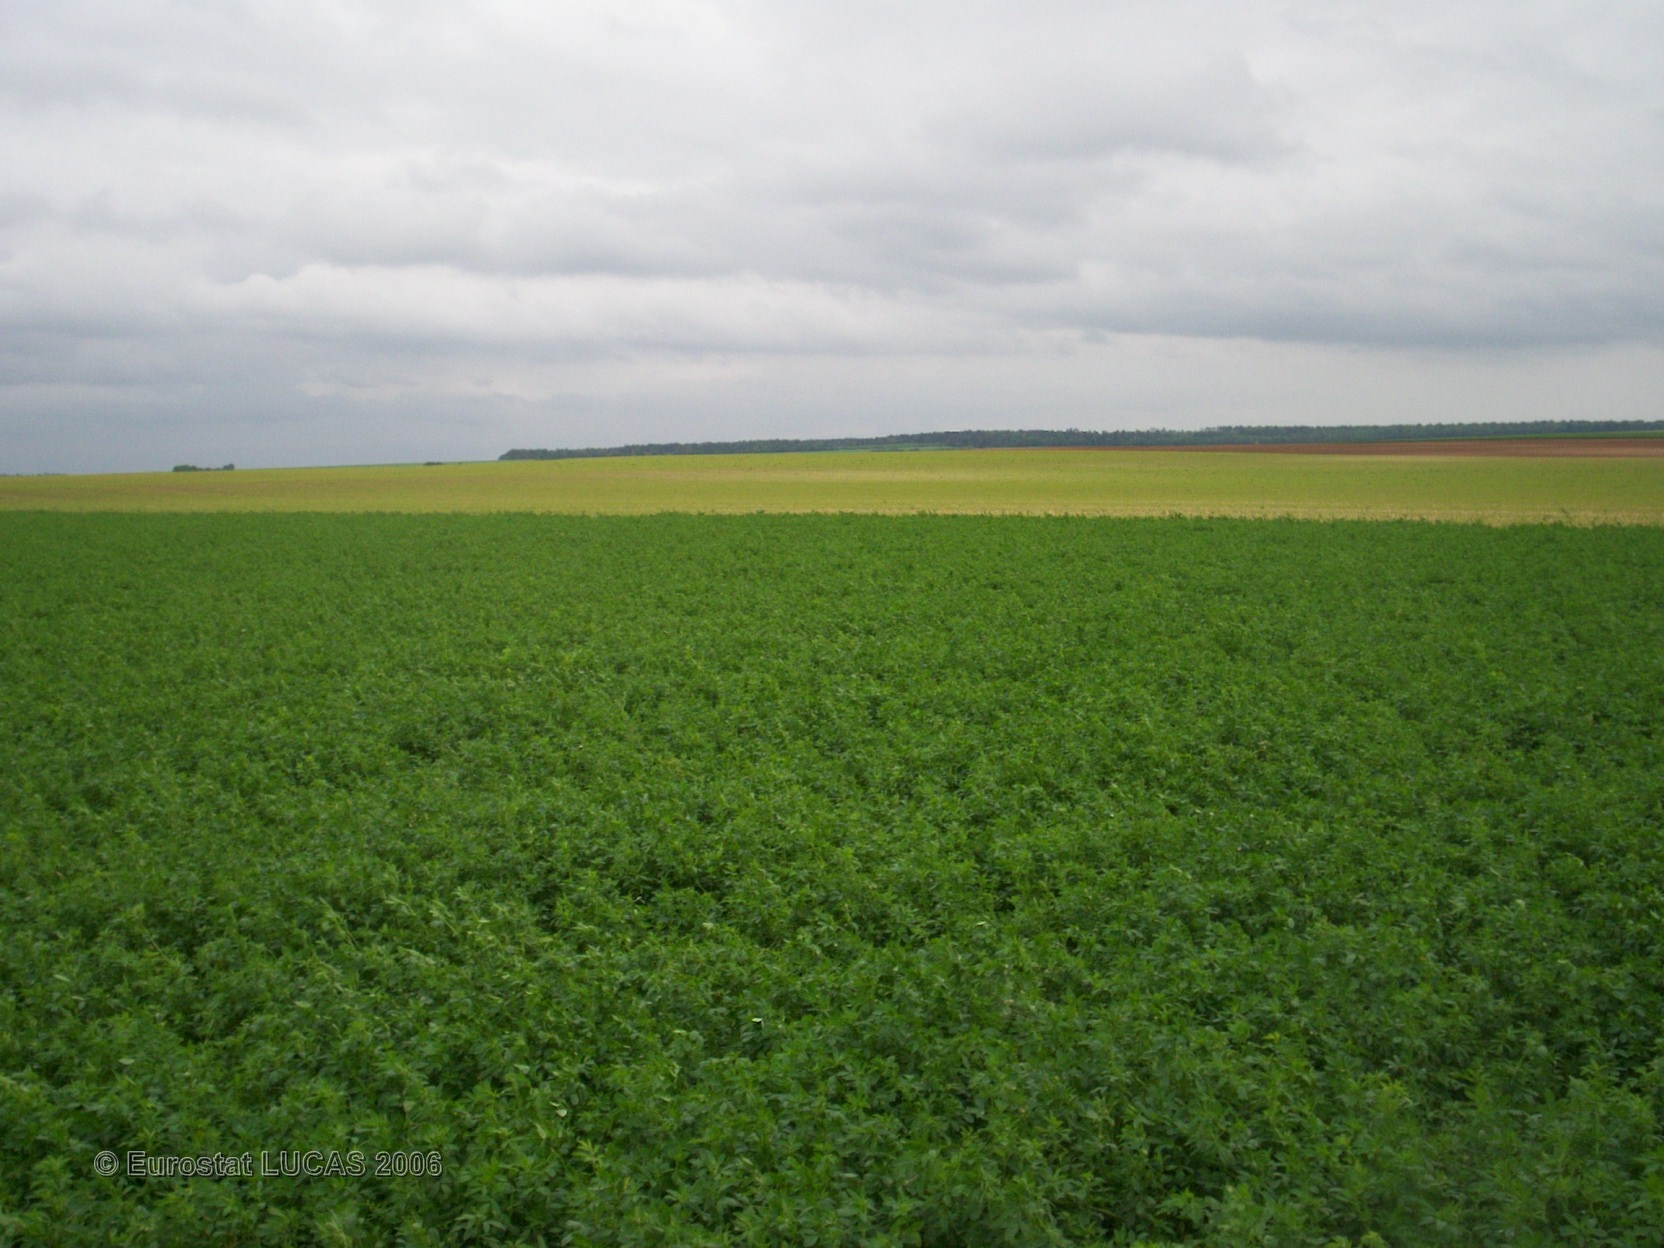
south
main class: Cropland
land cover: Lucerne
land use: Agriculture (excluding fallow land and kitchen gardens)
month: May
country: FR
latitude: 49.3943
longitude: 4.3330
